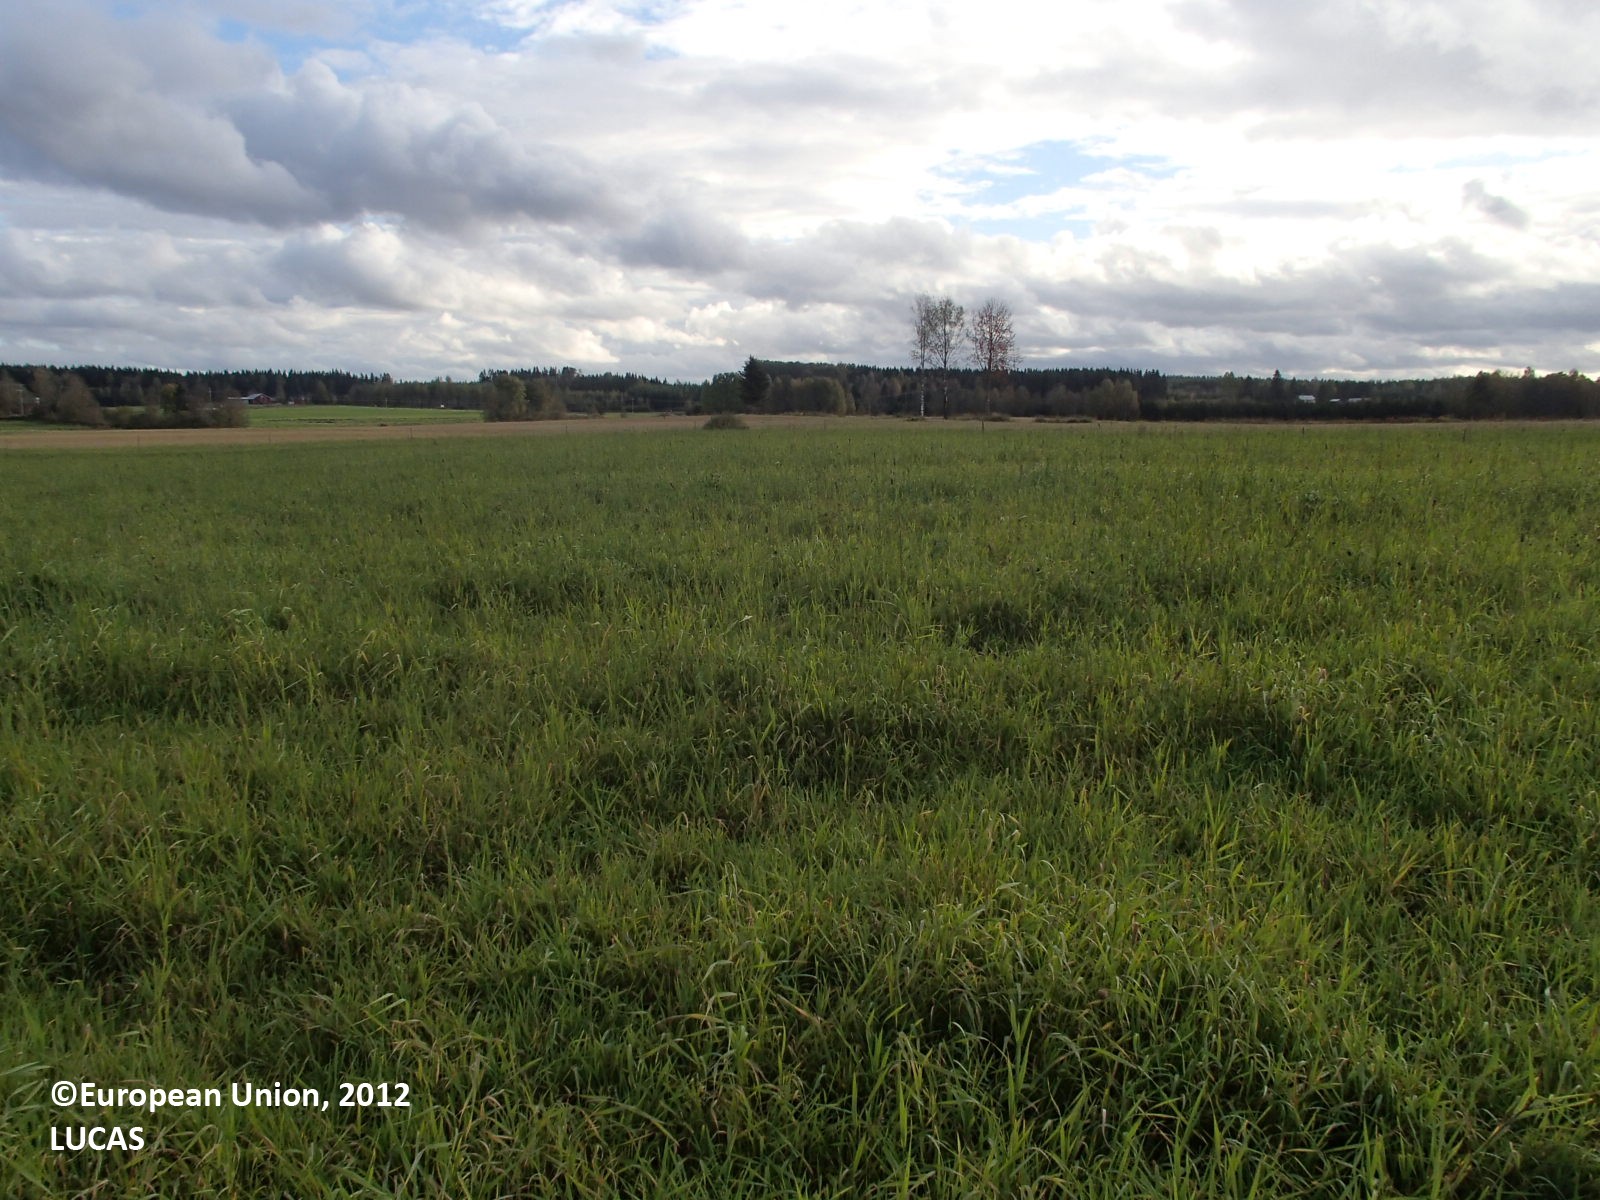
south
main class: Cropland
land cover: Temporary grasslands
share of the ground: > 75 %
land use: Agriculture (excluding fallow land and kitchen gardens)
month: September
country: FI
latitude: 63.3047
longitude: 27.9498
